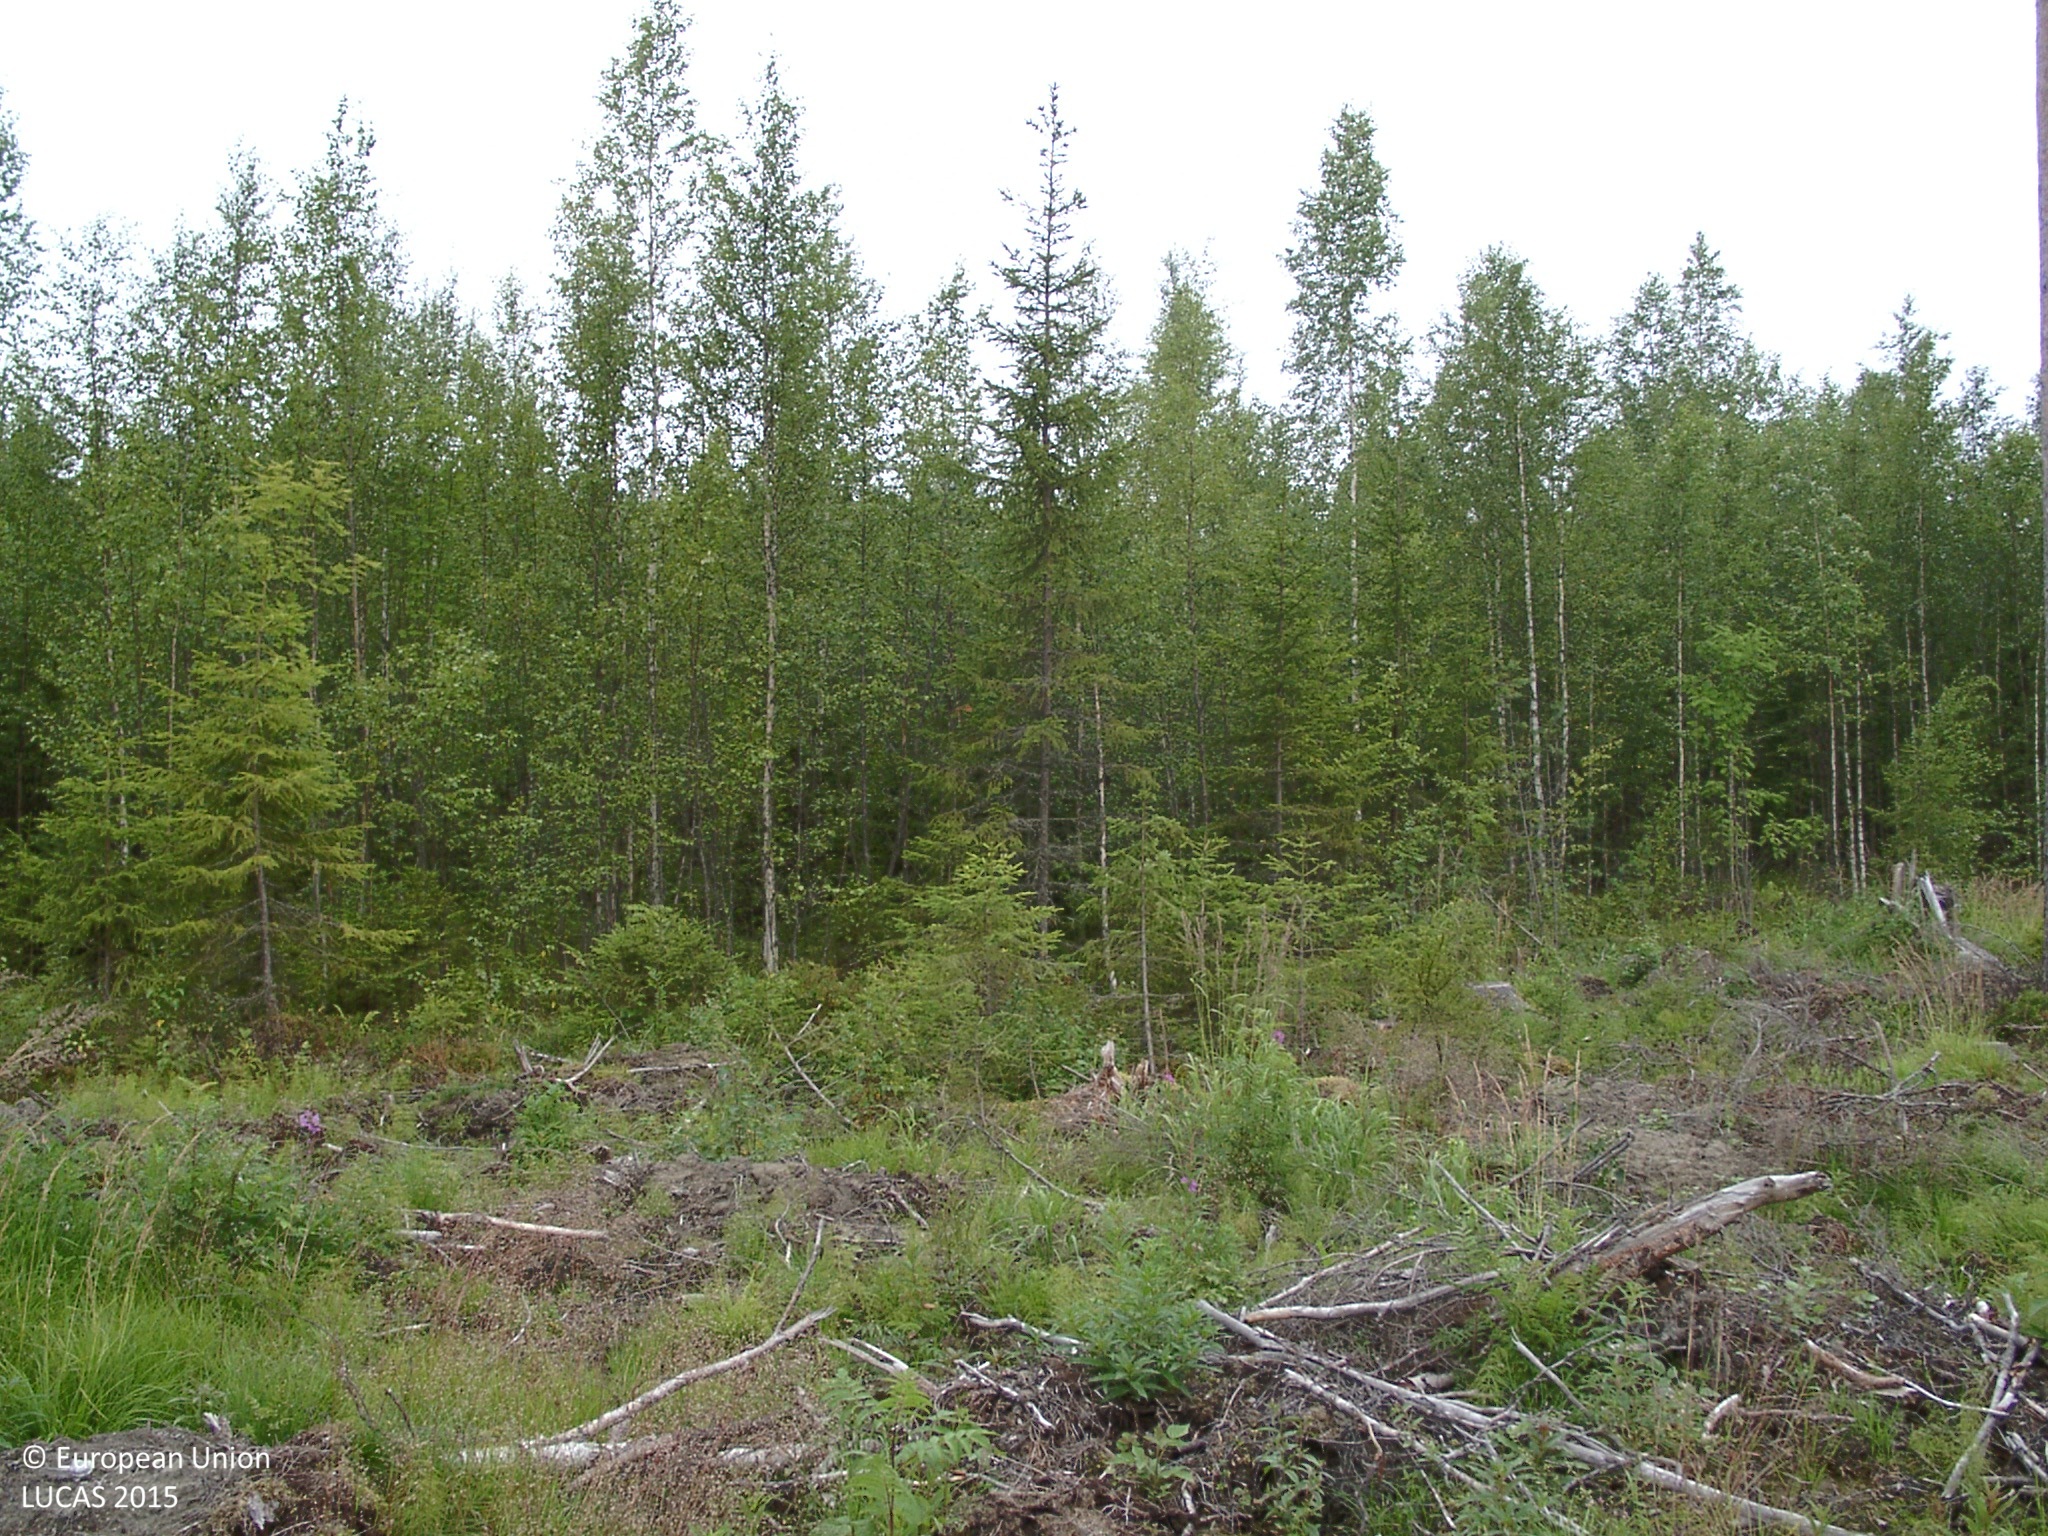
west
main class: Grassland
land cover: Grassland without tree/shrub cover
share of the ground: 50 - 75 %
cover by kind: herbaceous plants 50 %, unconsolidated bare surface 20 %, shrubs 5 %, lichens and mosses 5 %
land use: Forestry
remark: Clear cut
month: August
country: FI
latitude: 62.8830
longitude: 24.6611
